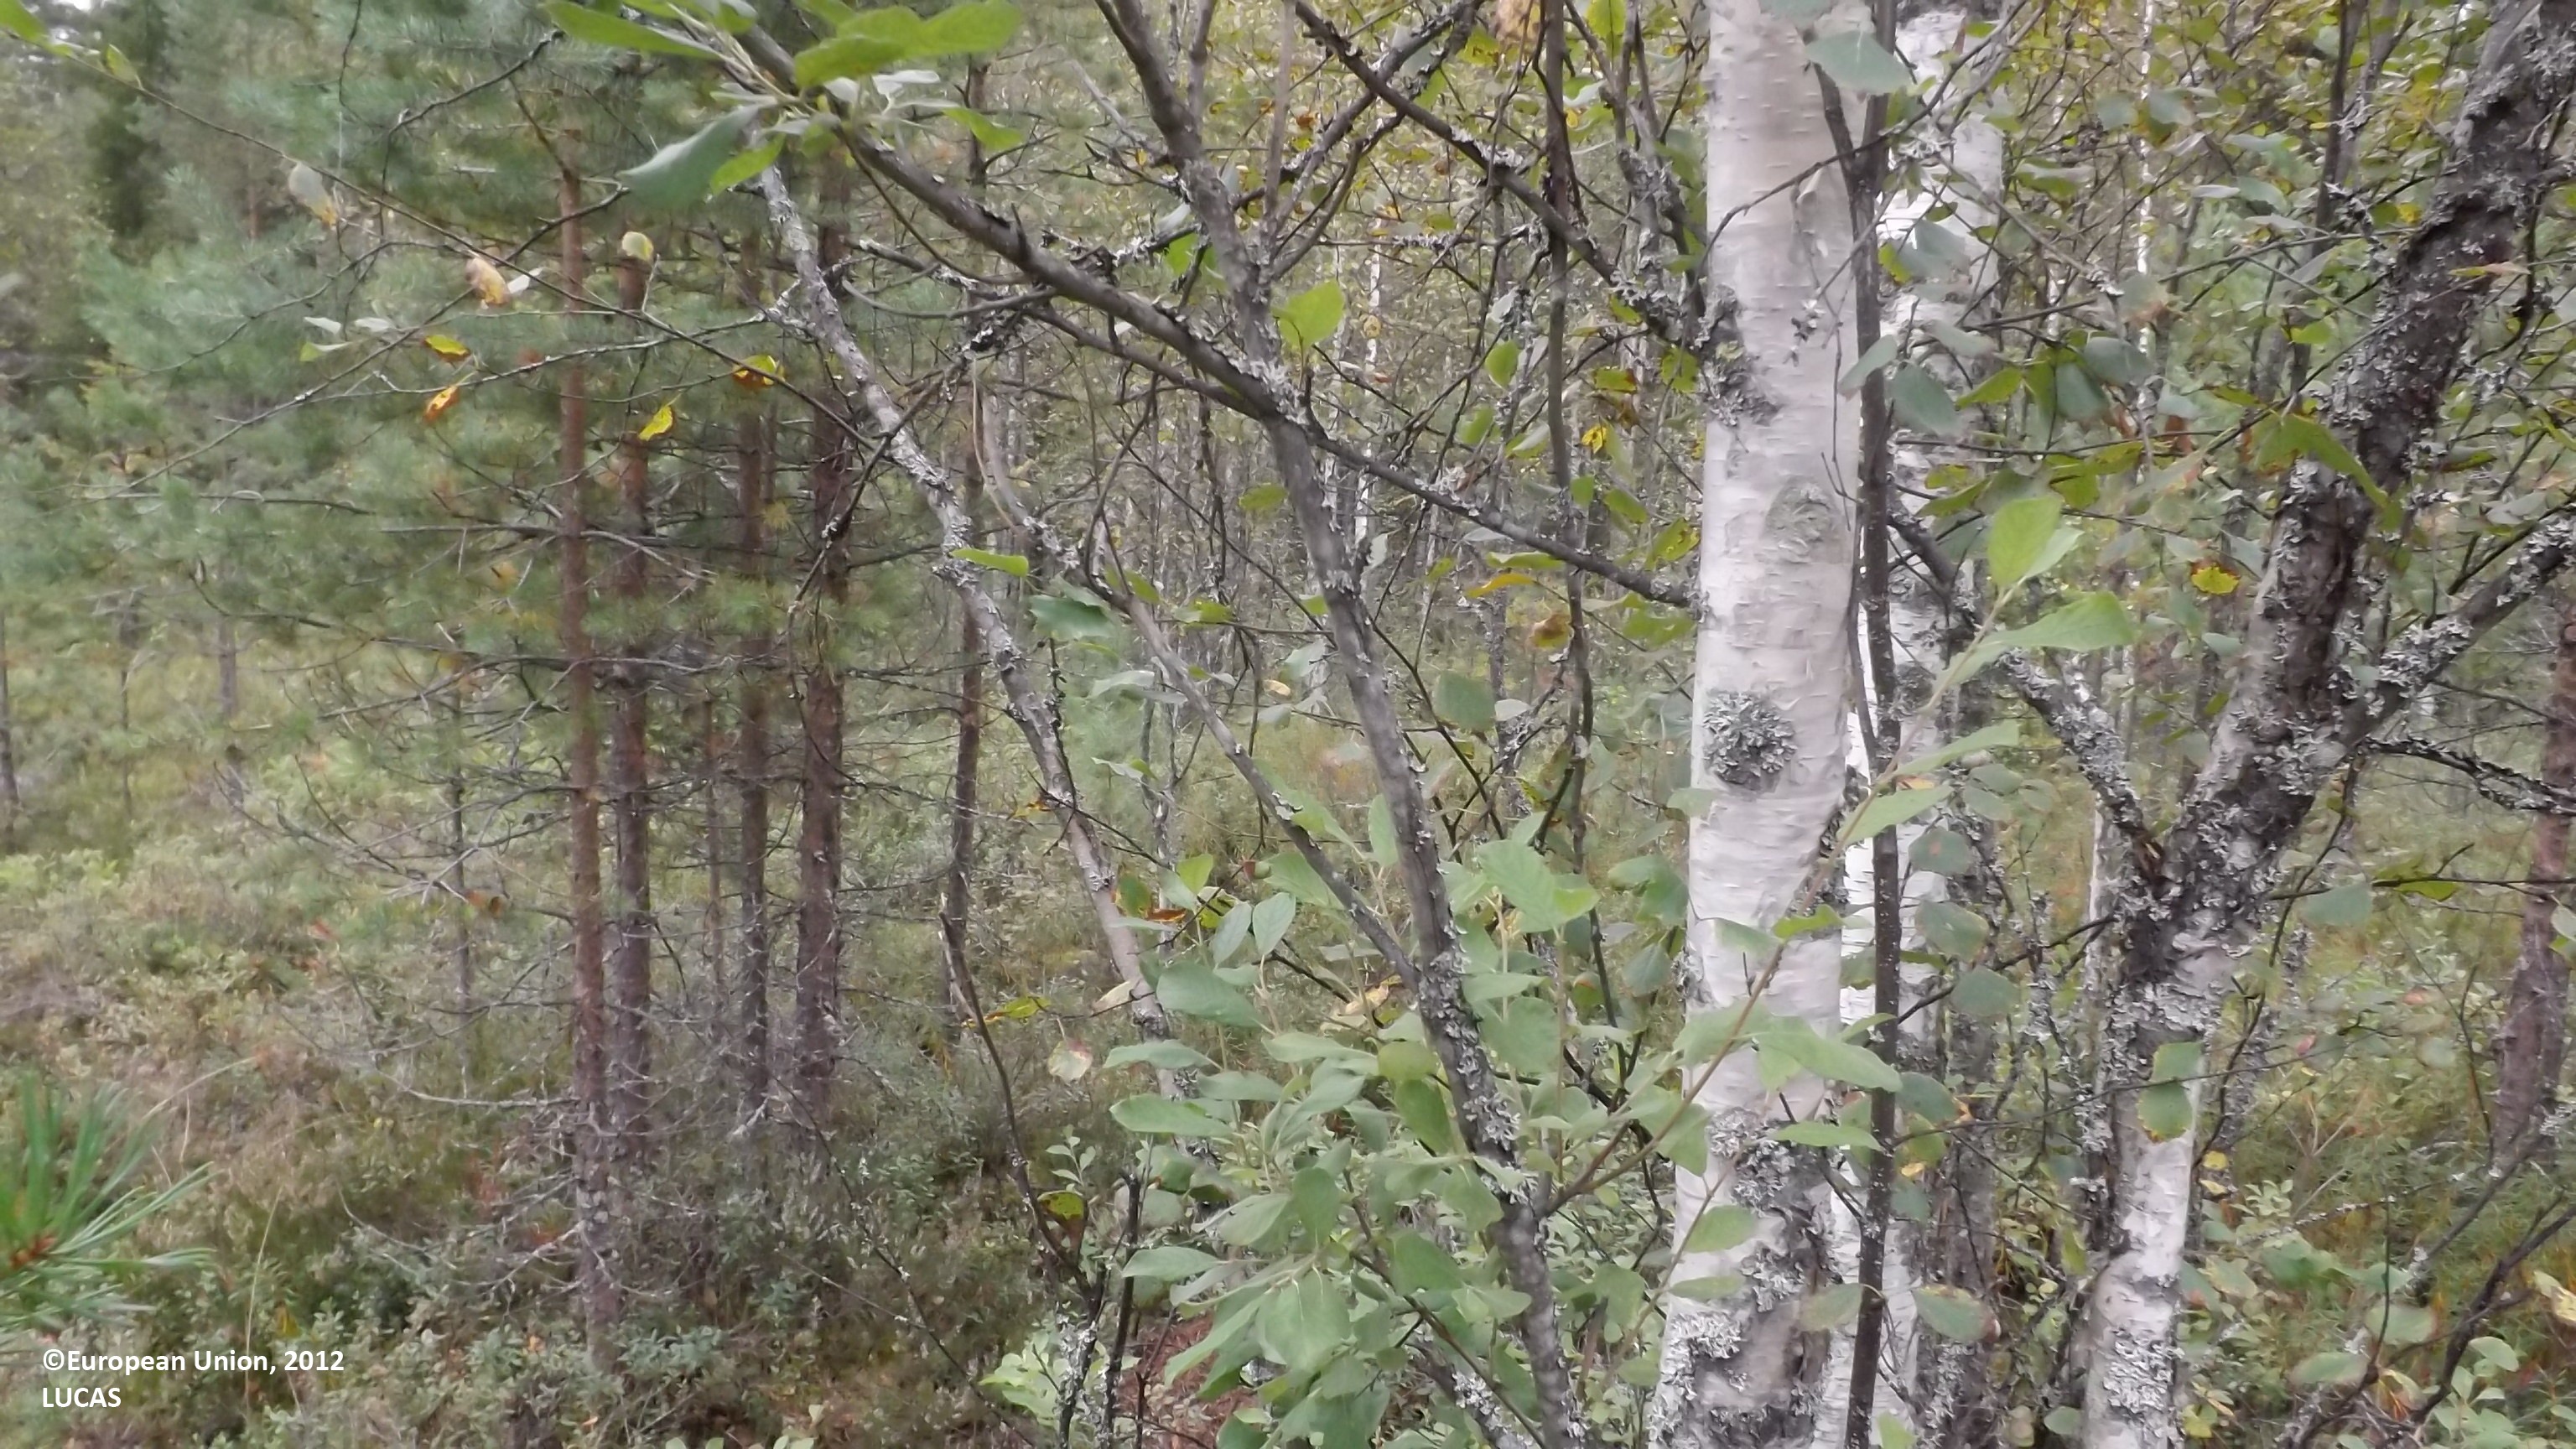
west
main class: Woodland
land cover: Pine dominated mixed woodland
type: boreal forest
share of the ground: 50 - 75 %
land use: Forestry
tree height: > 5 m
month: August
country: FI
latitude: 63.7734
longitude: 24.0014
